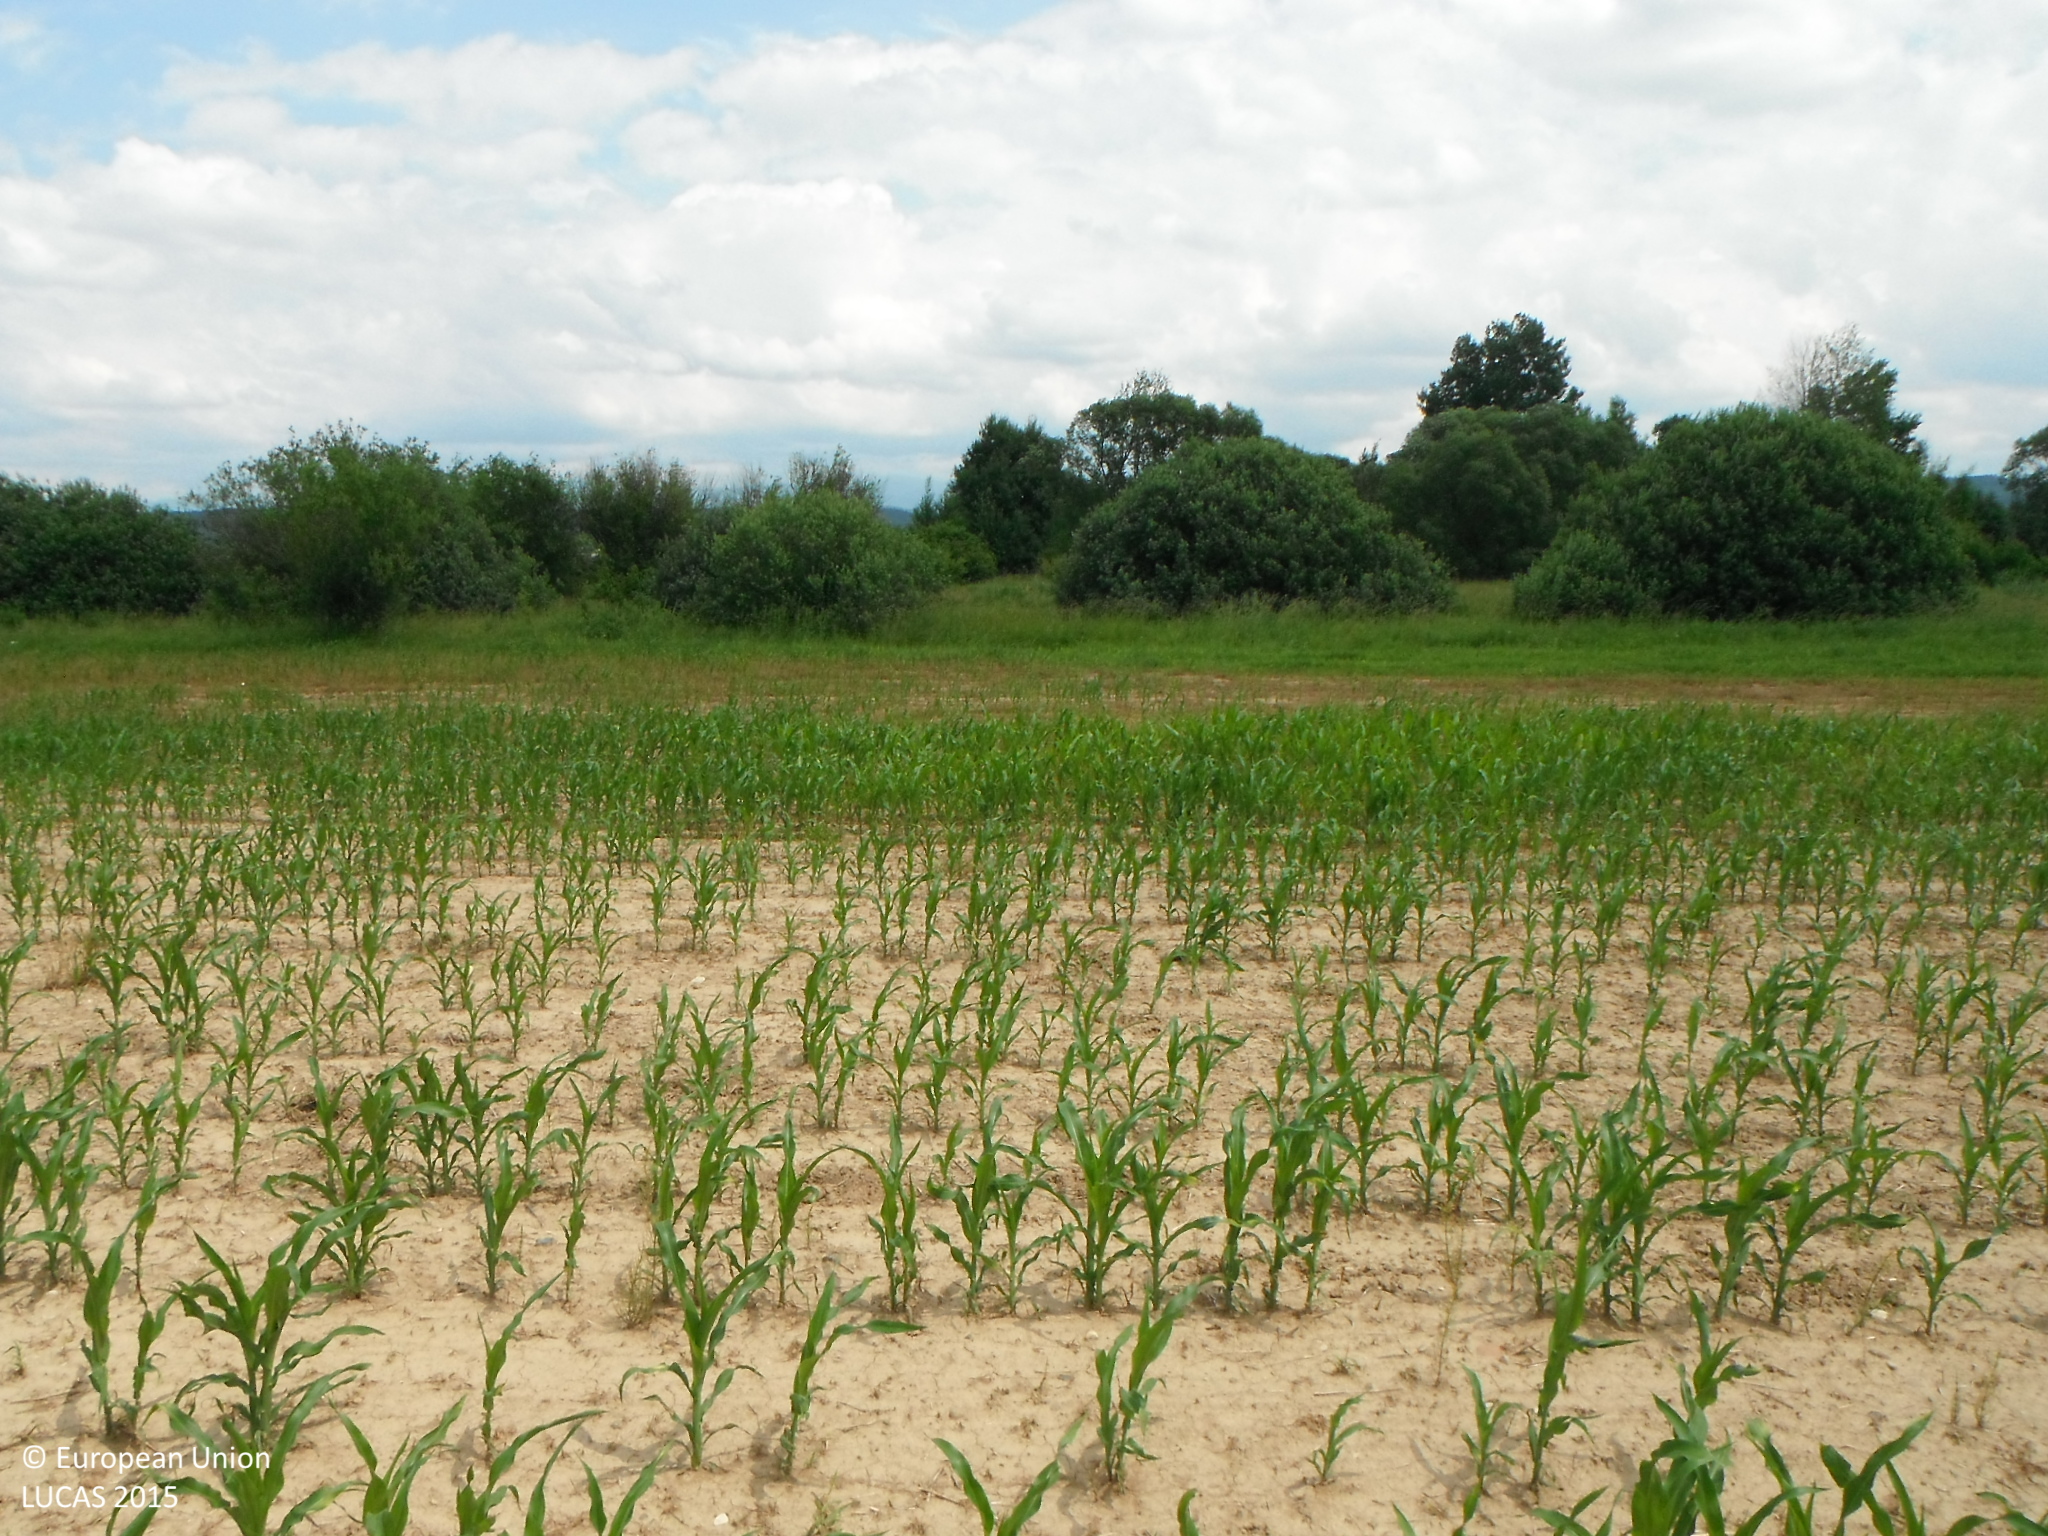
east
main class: Cropland
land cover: Maize
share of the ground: 25 - 50 %
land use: Agriculture (excluding fallow land and kitchen gardens)
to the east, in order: Maize; Spontaneously vegetated surfaces; Shrubland without tree cover; Spontaneously vegetated surfaces; Shrubland with sparse tree cover; Spontaneously vegetated surfaces; Ditches and canals; Spontaneously vegetated surfaces; Artificial constructions in urban areas
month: June
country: SK
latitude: 48.6408
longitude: 19.1283
